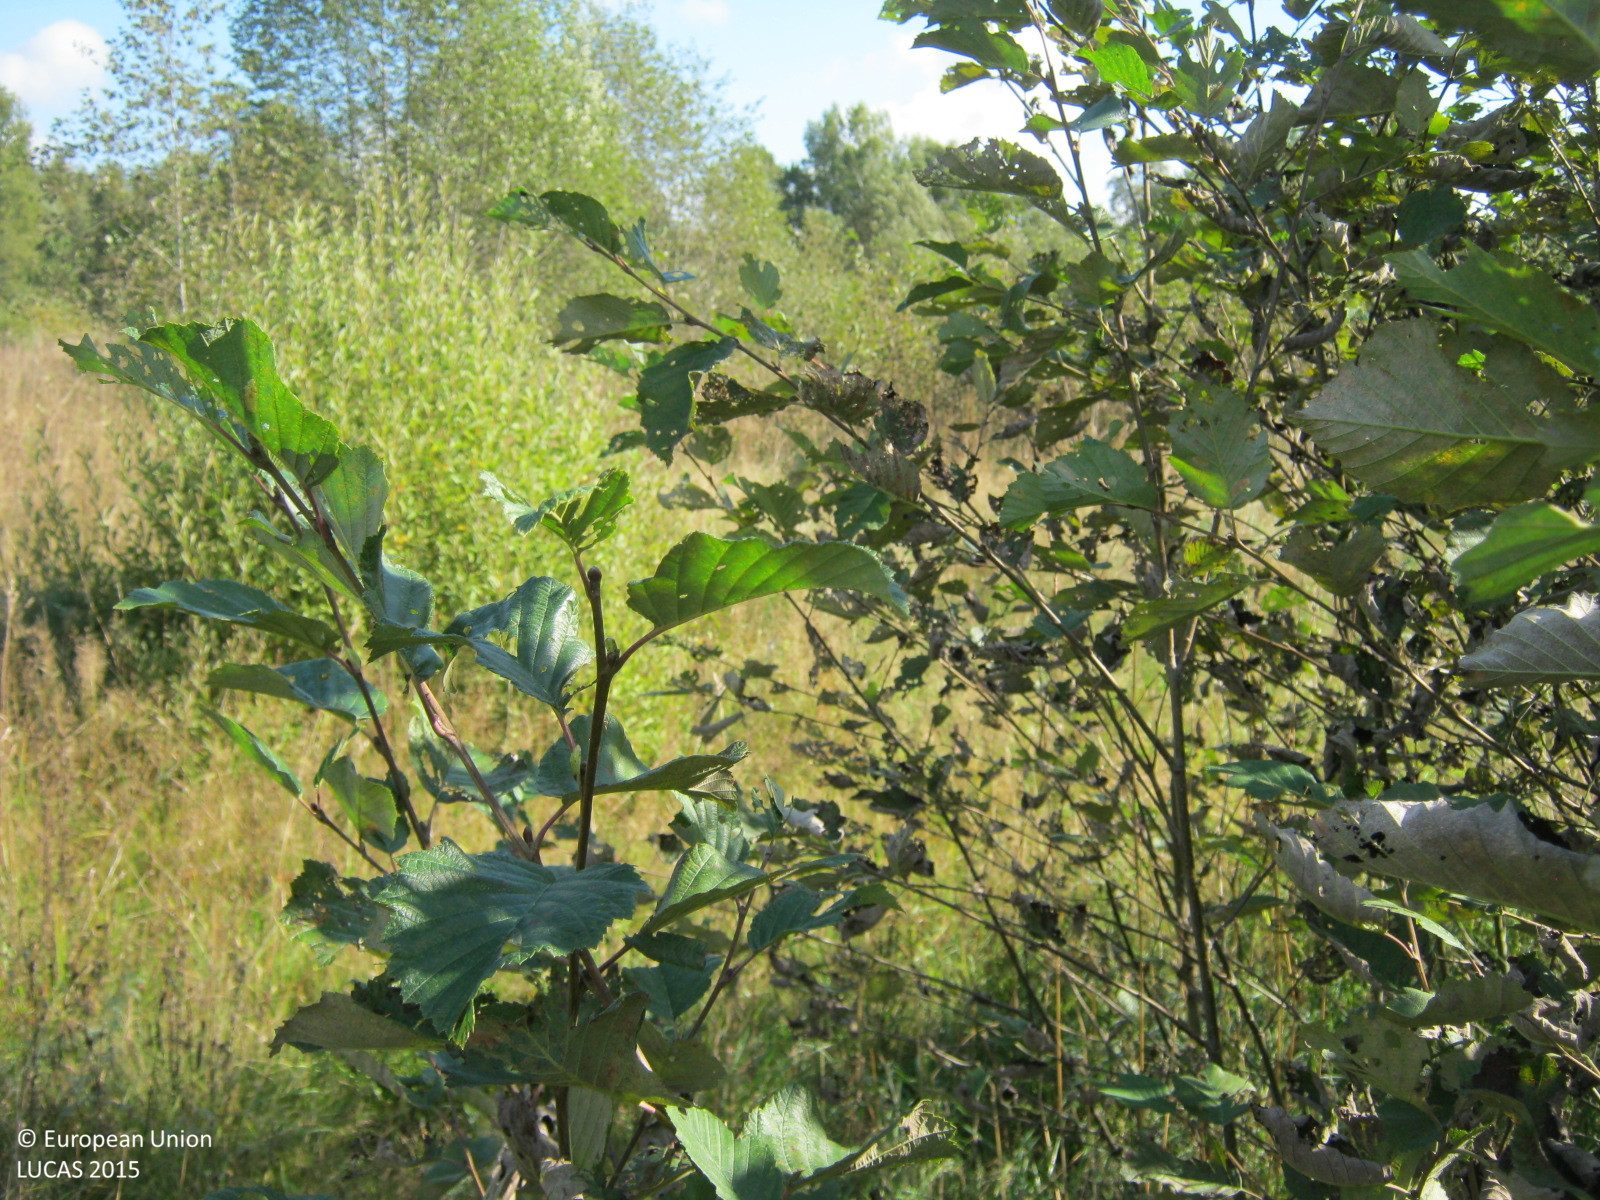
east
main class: Woodland
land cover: Broadleaved woodland
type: non-riverine alder, birch or aspen forest
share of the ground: 10 - 25 %
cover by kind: herbaceous plants 85 %, broadleaved forest trees 15 %
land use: Semi-natural and natural areas not in use
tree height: > 5 m
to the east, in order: Broadleaved woodland; Ditches and canals; Broadleaved woodland; Grassland without tree/shrub cover
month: September
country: LV
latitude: 57.3923
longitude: 24.4833
